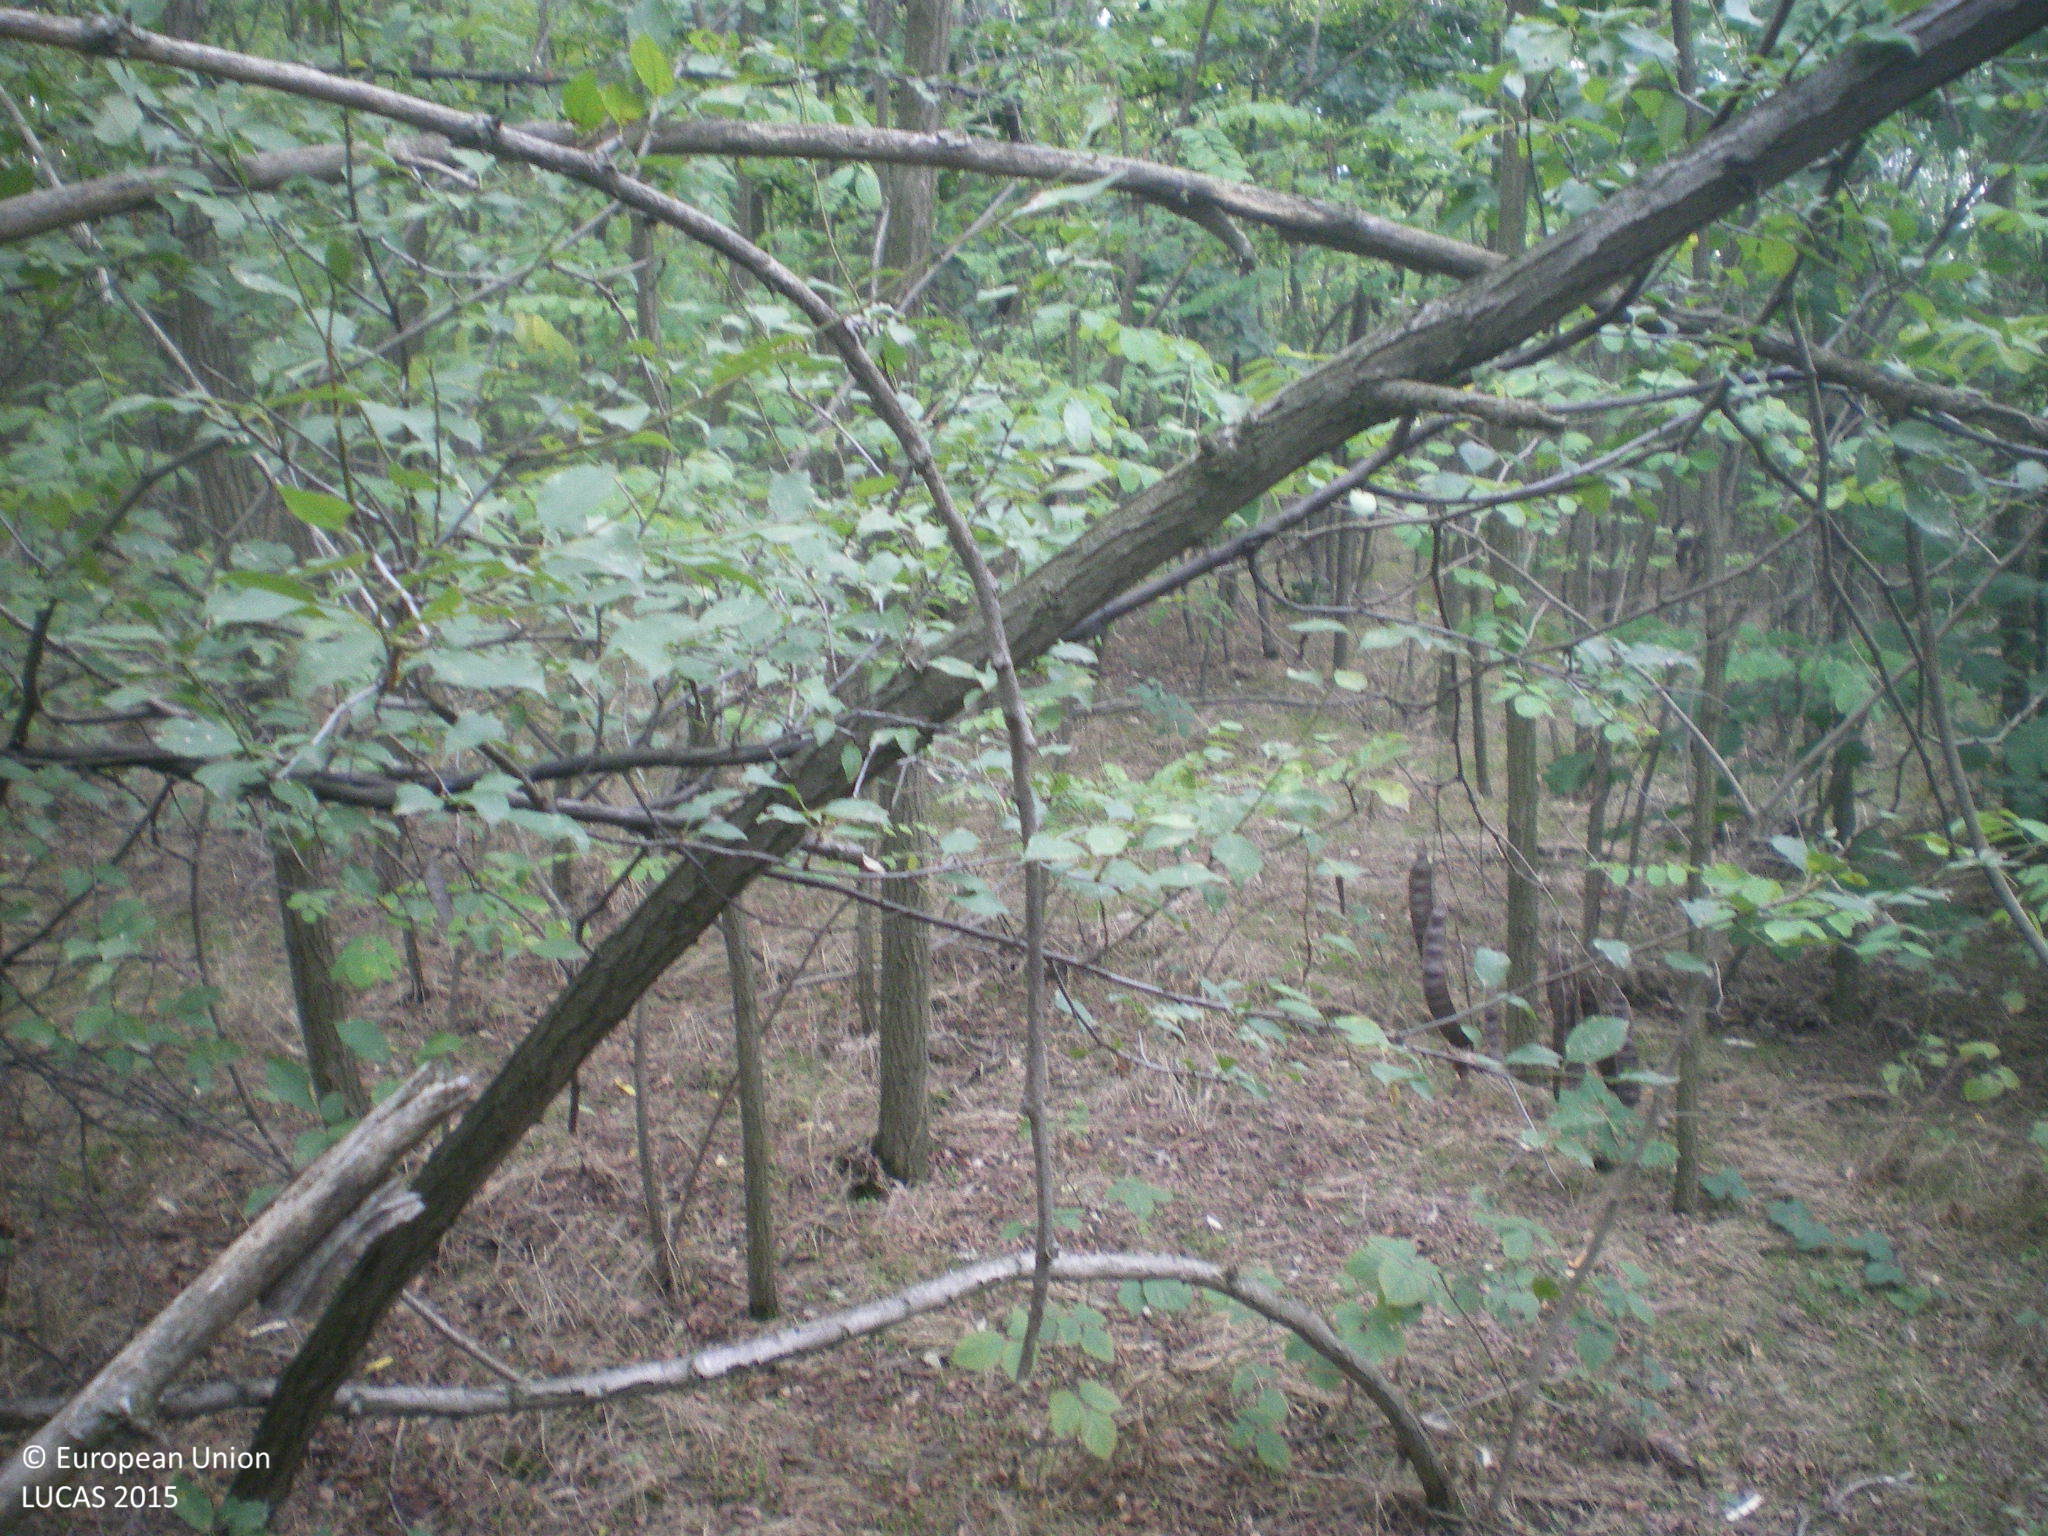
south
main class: Woodland
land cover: Broadleaved woodland
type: mesophytic deciduous forest
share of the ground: > 75 %
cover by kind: broadleaved forest trees 95 %, unconsolidated bare surface 5 %
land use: Forestry
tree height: > 5 m
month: October
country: BG
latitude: 42.1713
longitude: 25.9456
